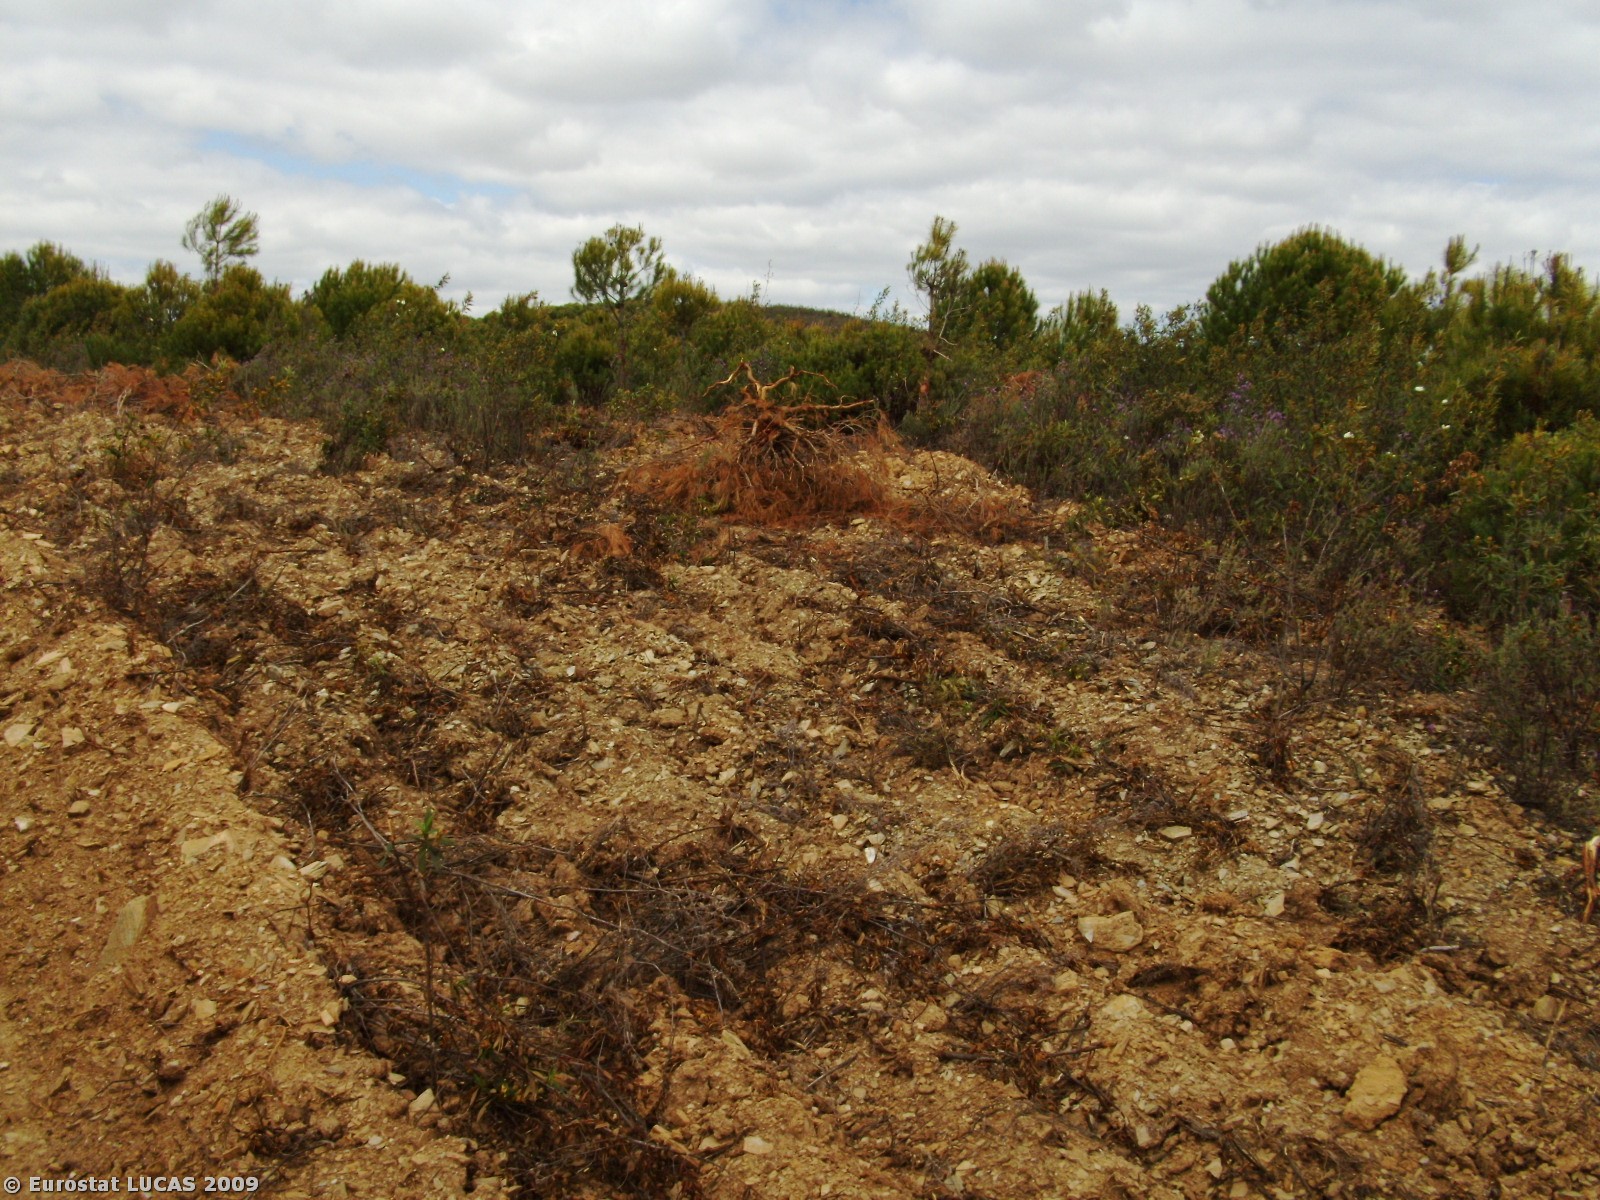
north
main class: Grassland
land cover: Spontaneously vegetated surfaces
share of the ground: > 75 %
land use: Fallow land
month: April
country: PT
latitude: 39.7865
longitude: -7.5092
